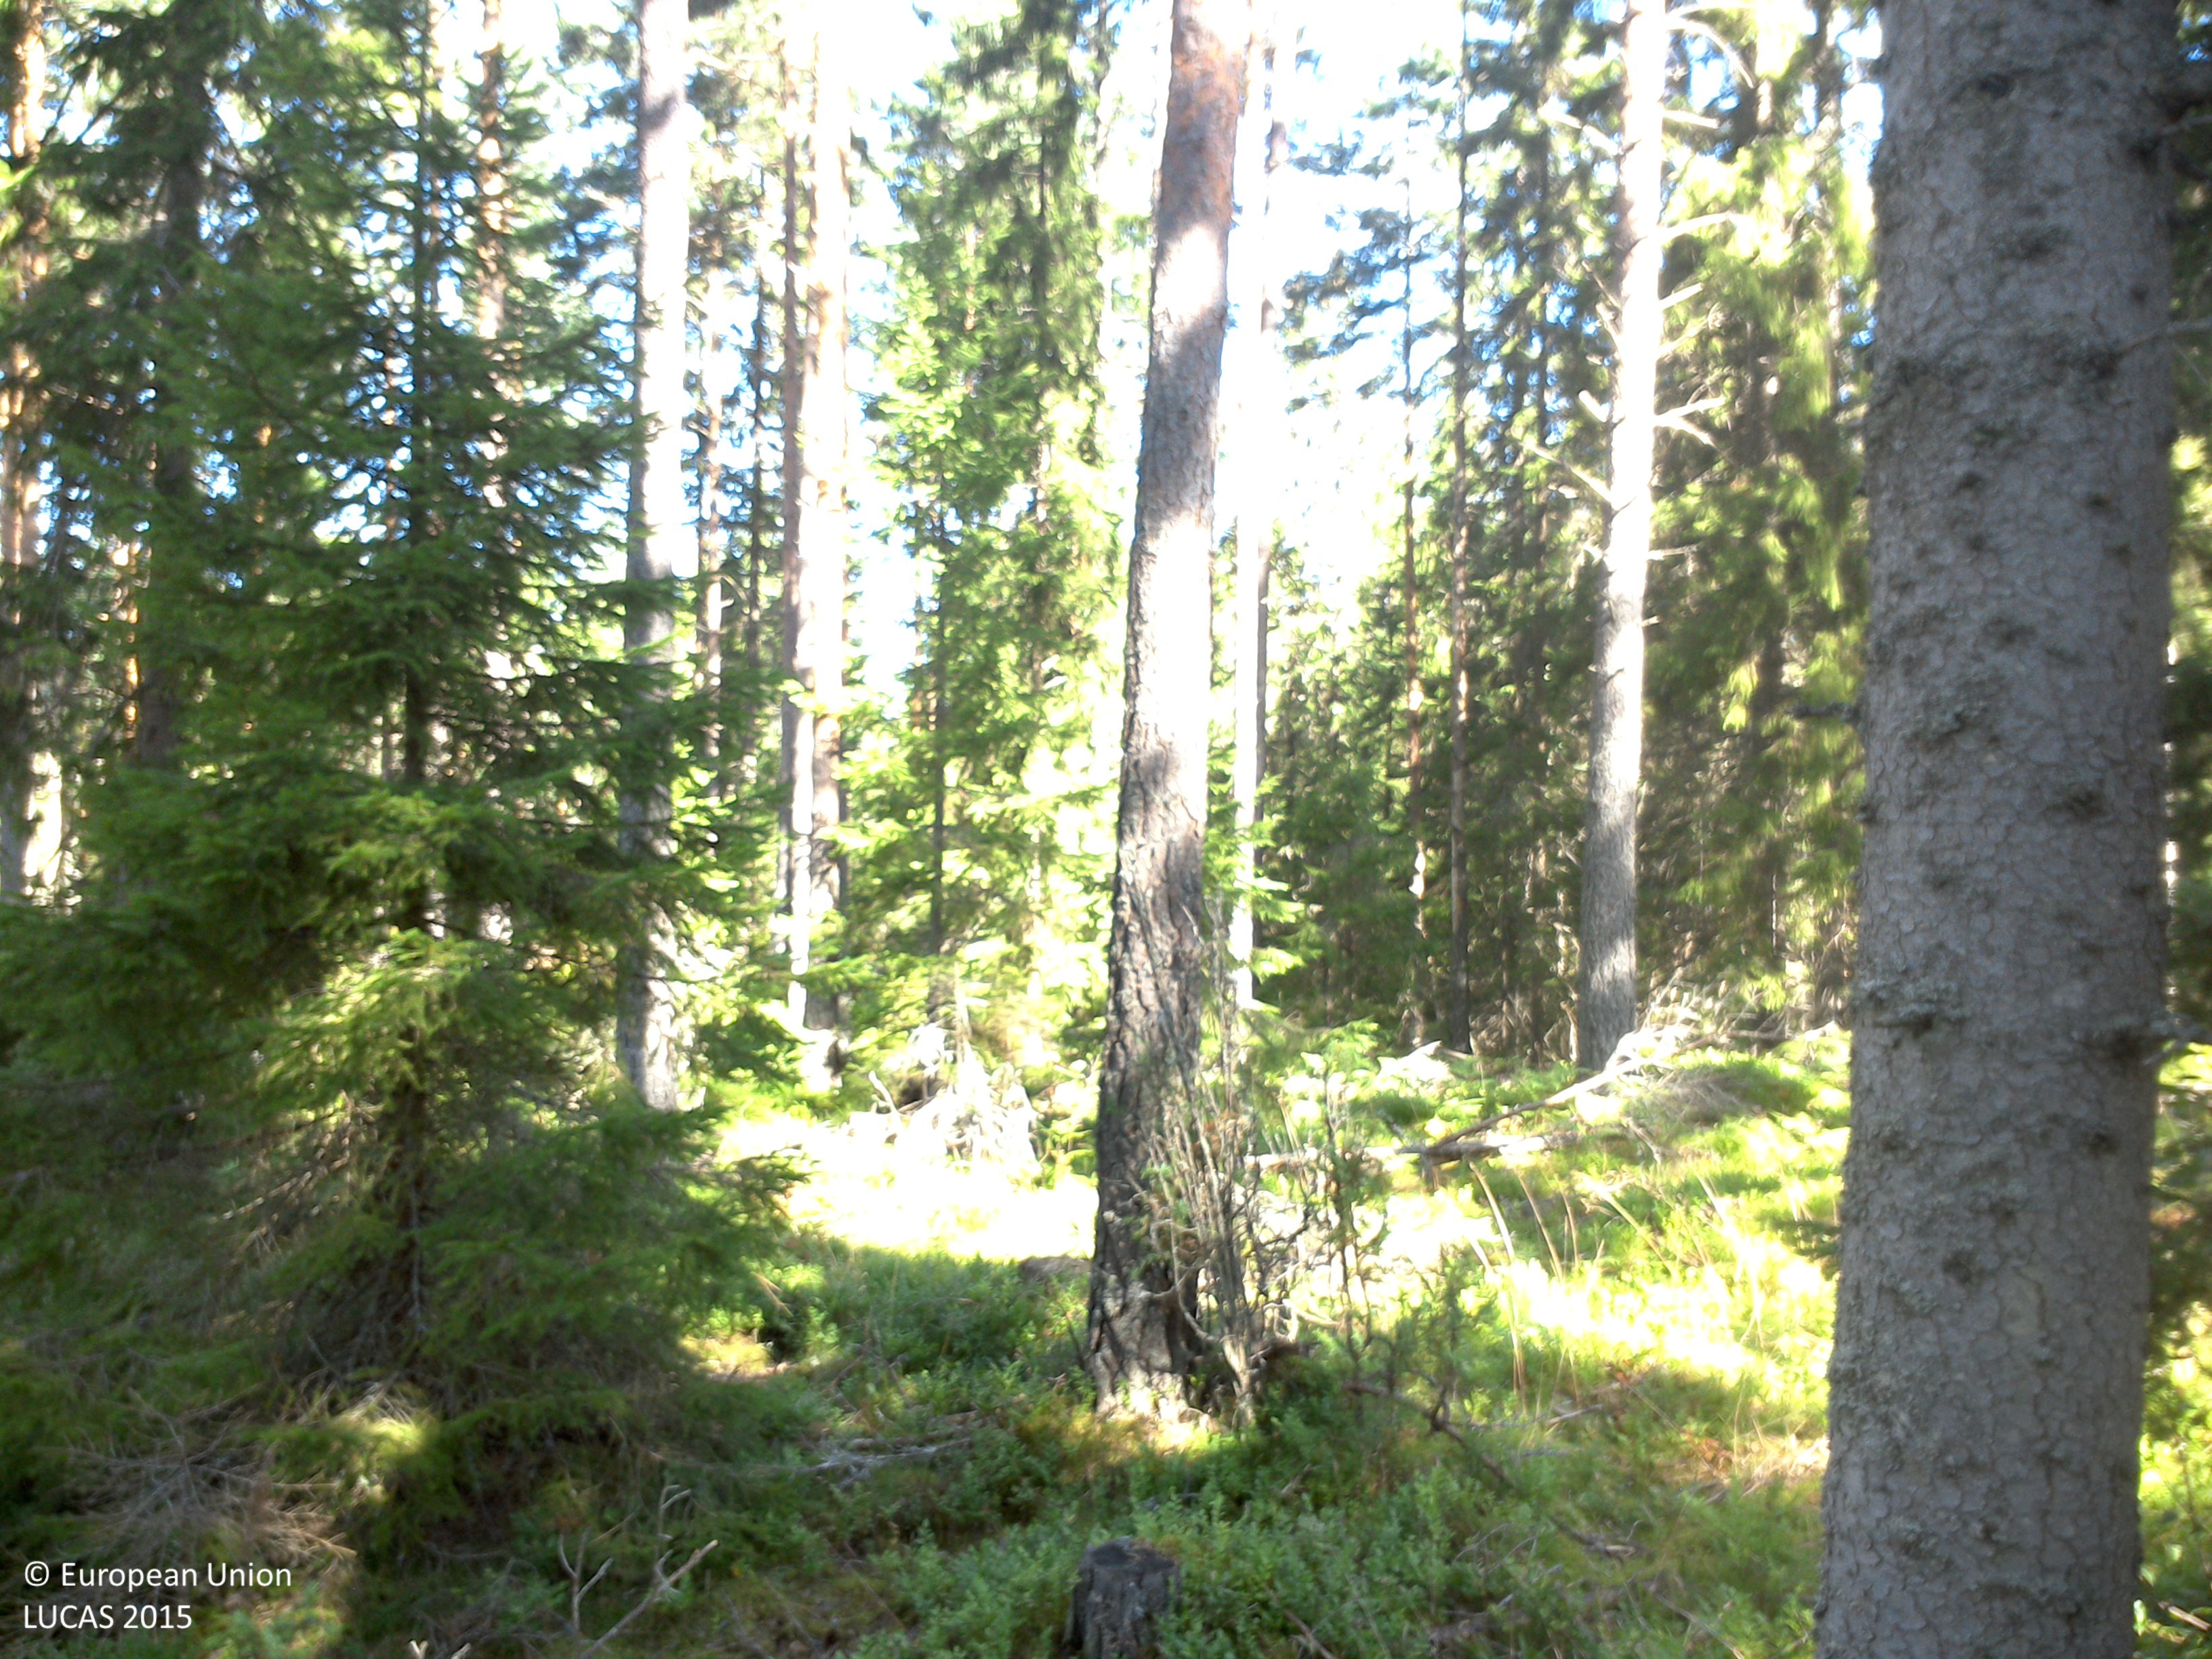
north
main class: Woodland
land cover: Pine dominated coniferous woodland
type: boreal forest
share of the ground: 25 - 50 %
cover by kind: coniferous forest trees 40 %, lichens and mosses 40 %, herbaceous plants 20 %
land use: Forestry
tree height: > 5 m
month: August
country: SE
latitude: 57.8804
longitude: 15.3074
